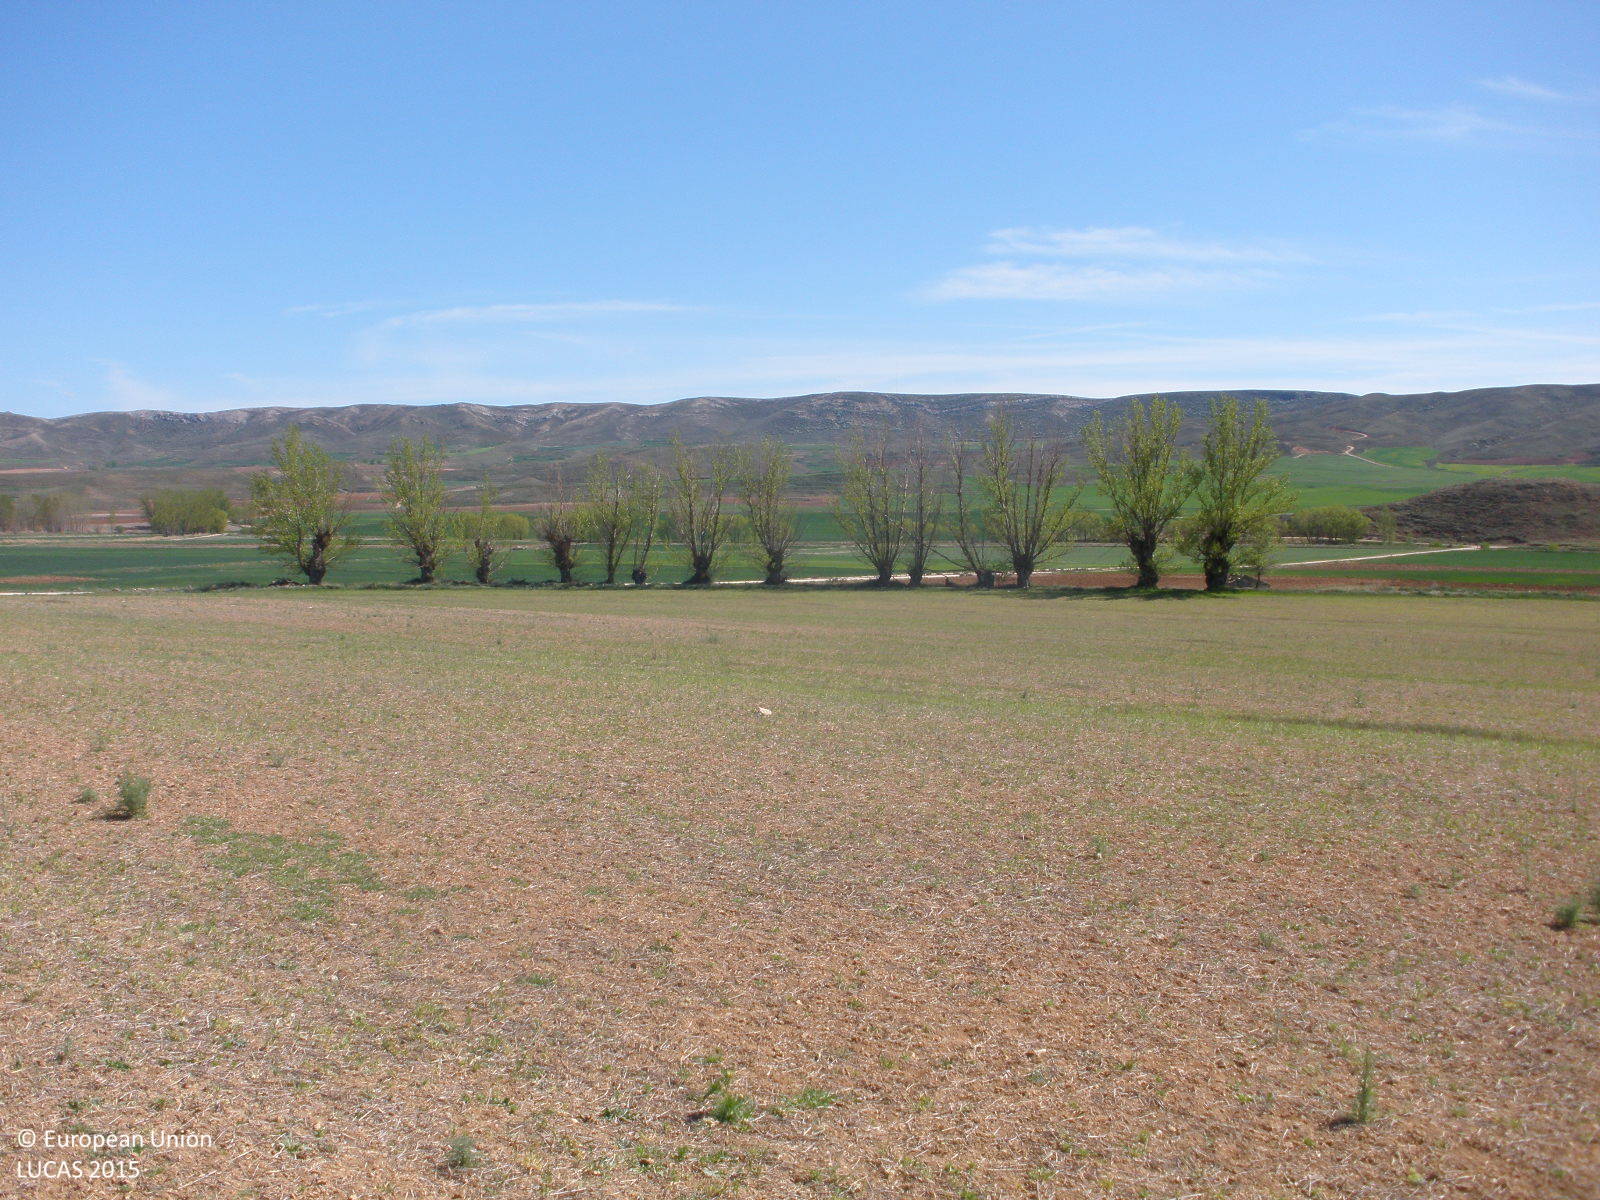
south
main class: Grassland
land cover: Spontaneously vegetated surfaces
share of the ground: 25 - 50 %
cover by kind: unconsolidated bare surface 60 %, herbaceous plants 40 %
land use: Agriculture (excluding fallow land and kitchen gardens)
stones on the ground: < 10 %
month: May
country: ES
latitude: 40.6887
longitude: -0.8157
